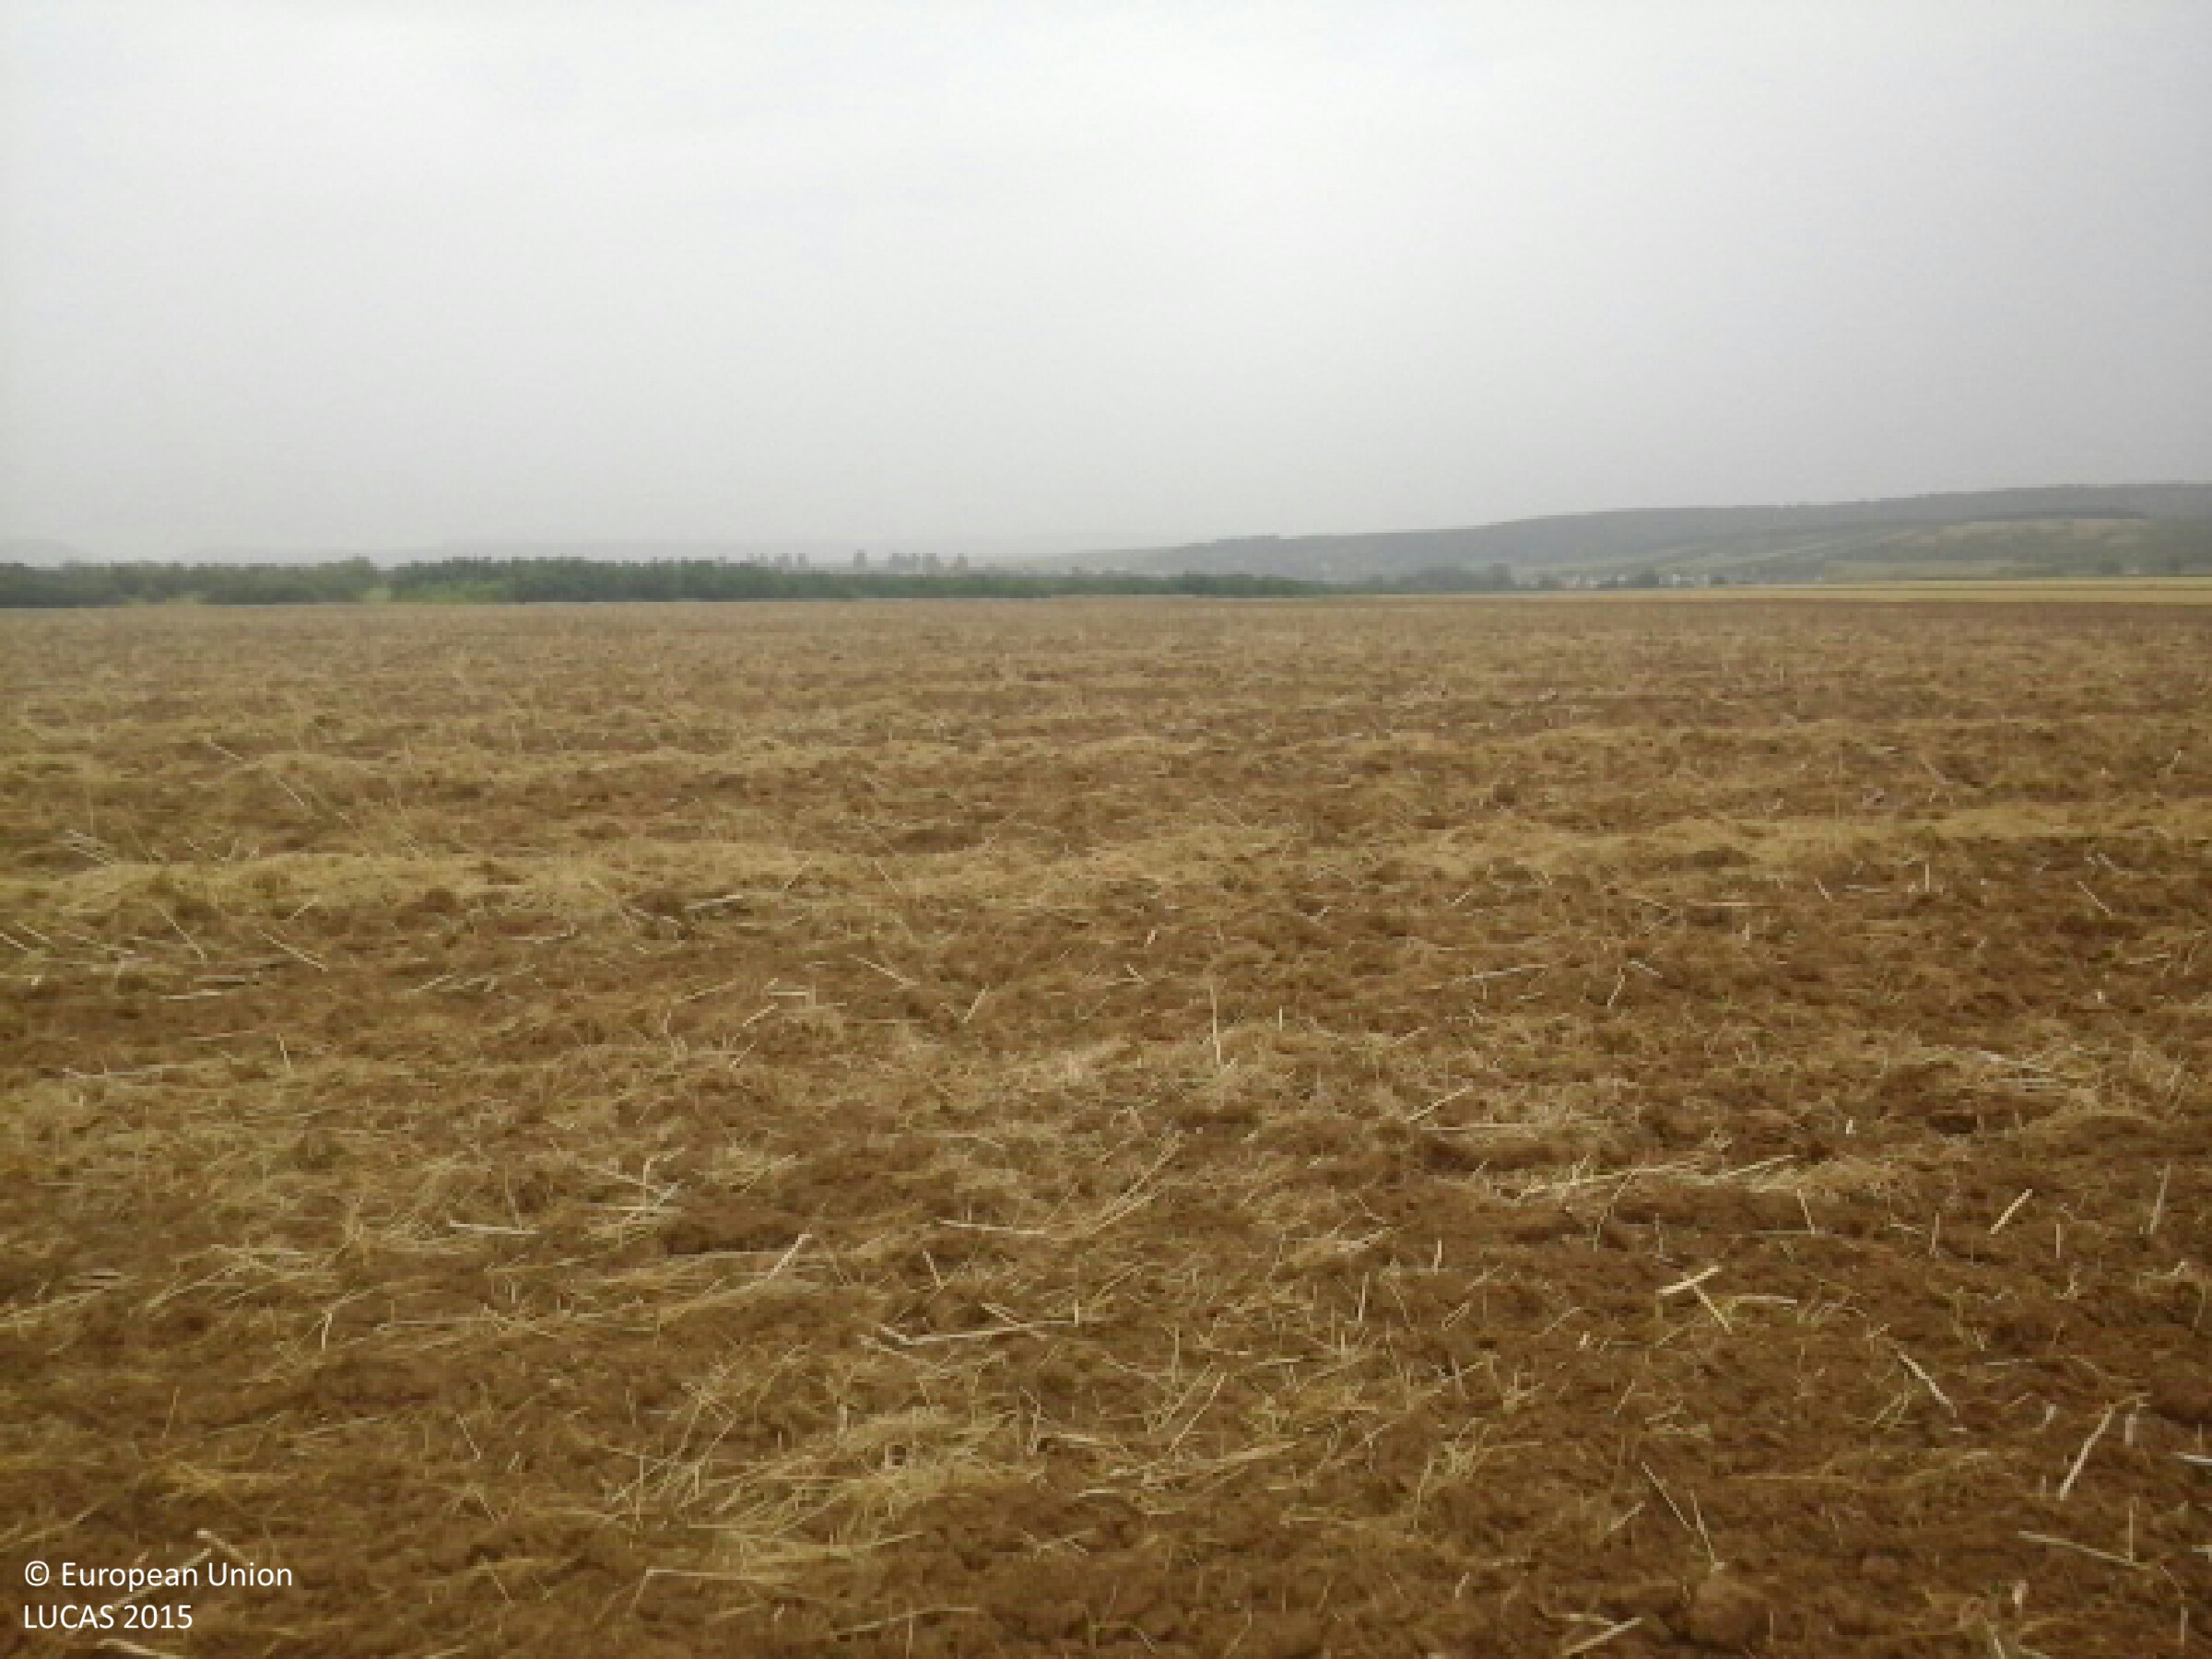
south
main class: Cropland
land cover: Rape and turnip rape
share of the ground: < 10 %
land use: Agriculture (excluding fallow land and kitchen gardens)
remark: Harvested field
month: July
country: HU
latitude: 48.4025
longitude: 21.1319
